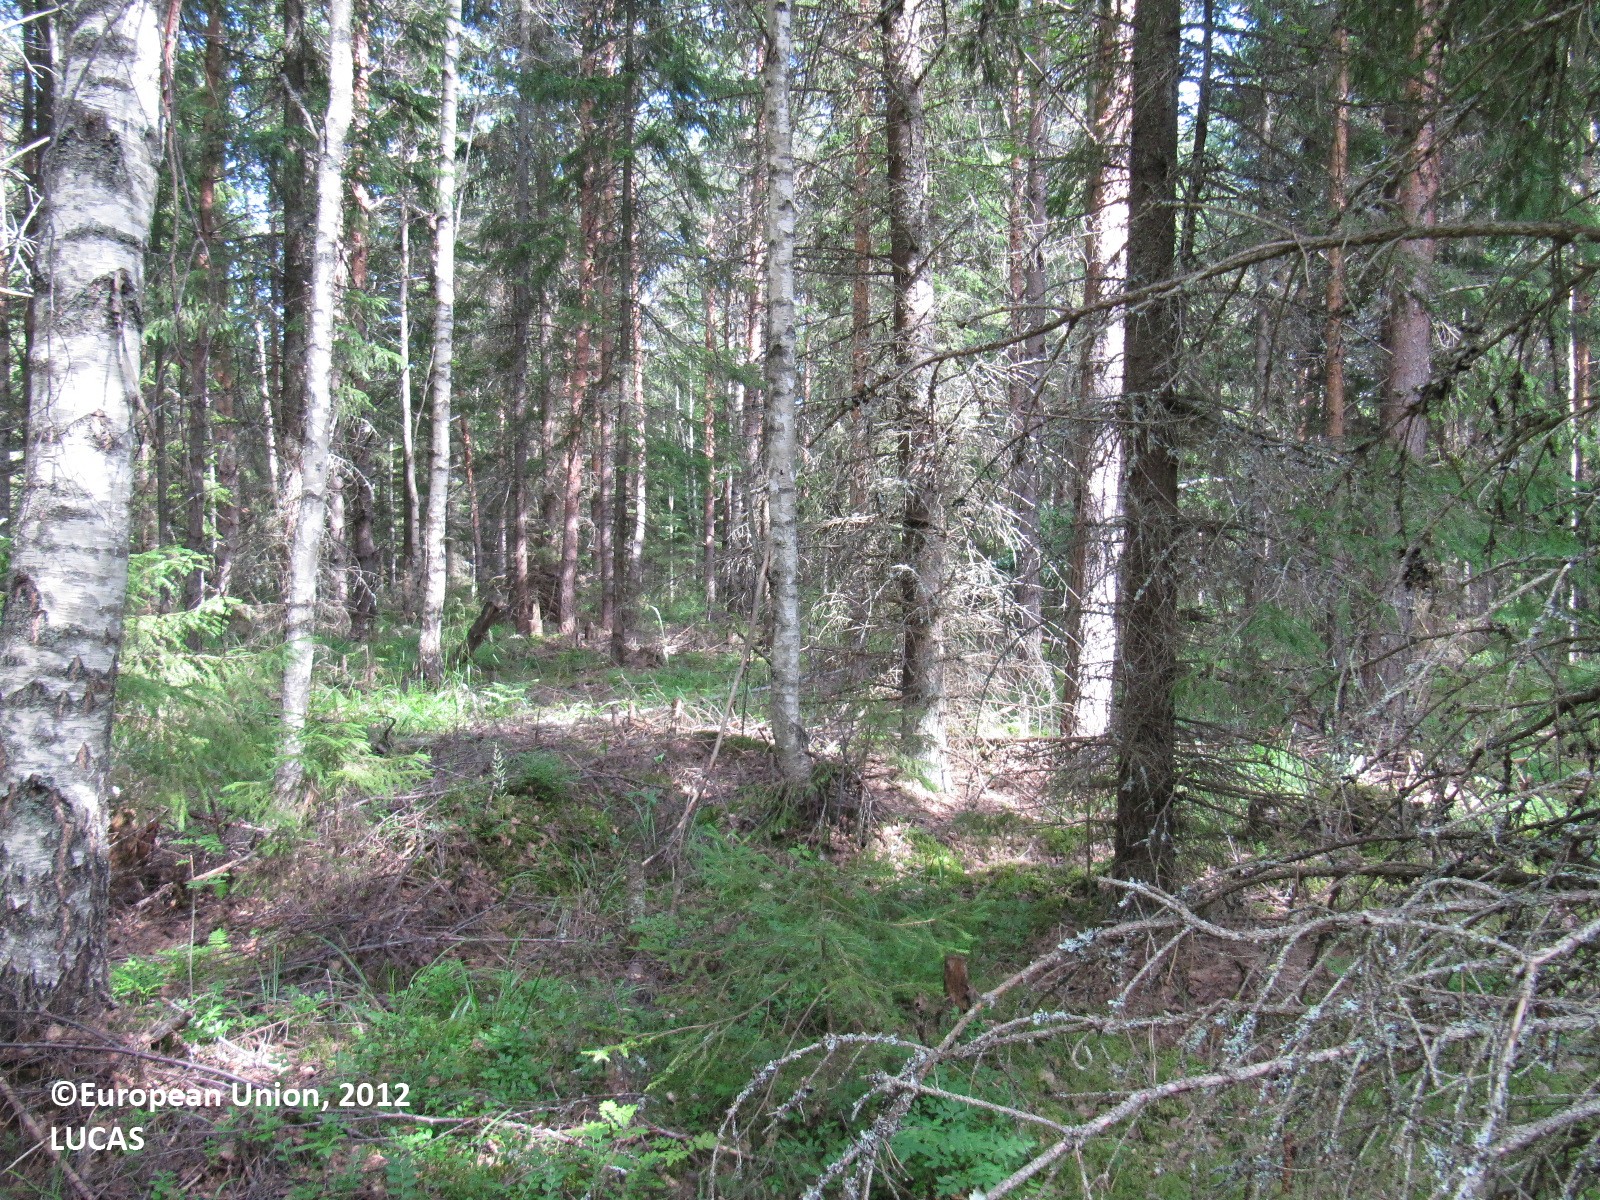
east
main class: Woodland
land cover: Spruce dominated mixed woodland
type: boreal forest
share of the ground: > 75 %
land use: Forestry
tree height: > 5 m
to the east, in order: Spruce dominated mixed woodland; Other mixed woodland
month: July
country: FI
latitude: 61.0152
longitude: 24.2117
